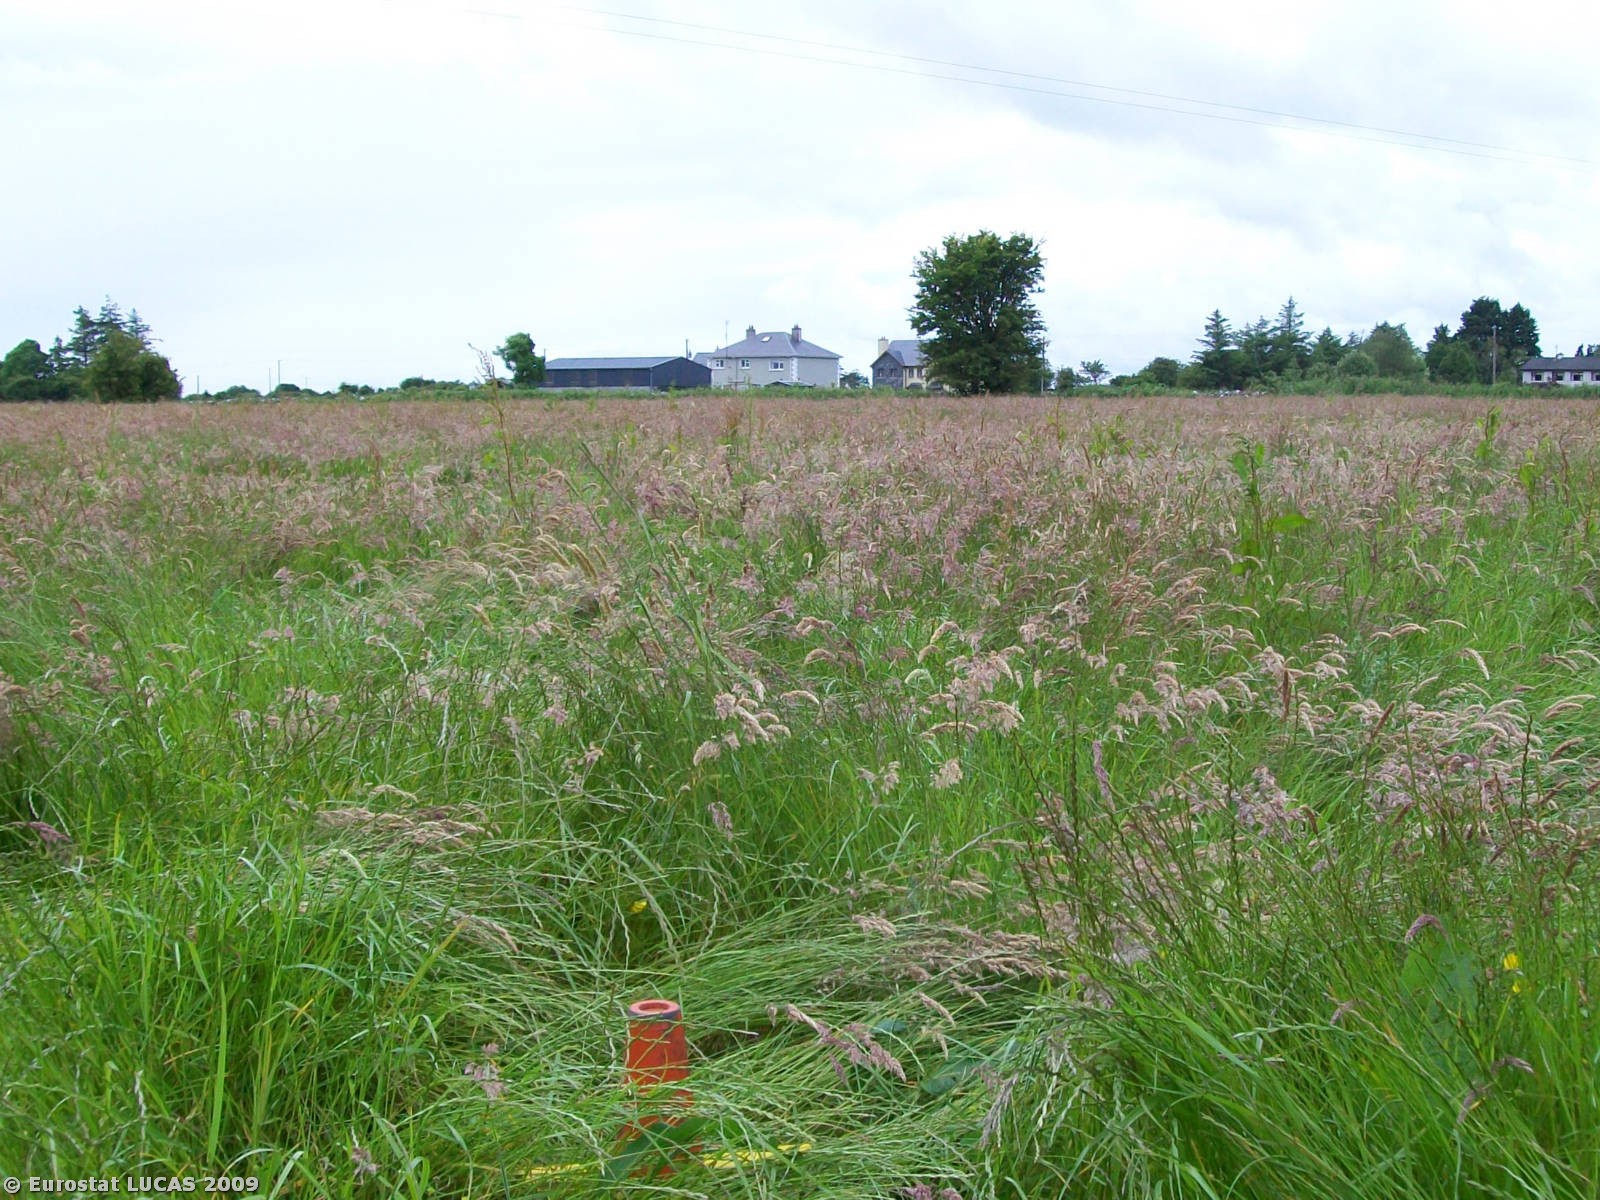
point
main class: Grassland
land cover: Grassland without tree/shrub cover
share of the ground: > 75 %
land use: Agriculture (excluding fallow land and kitchen gardens)
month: June
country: IE
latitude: 53.3838
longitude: -8.8336
